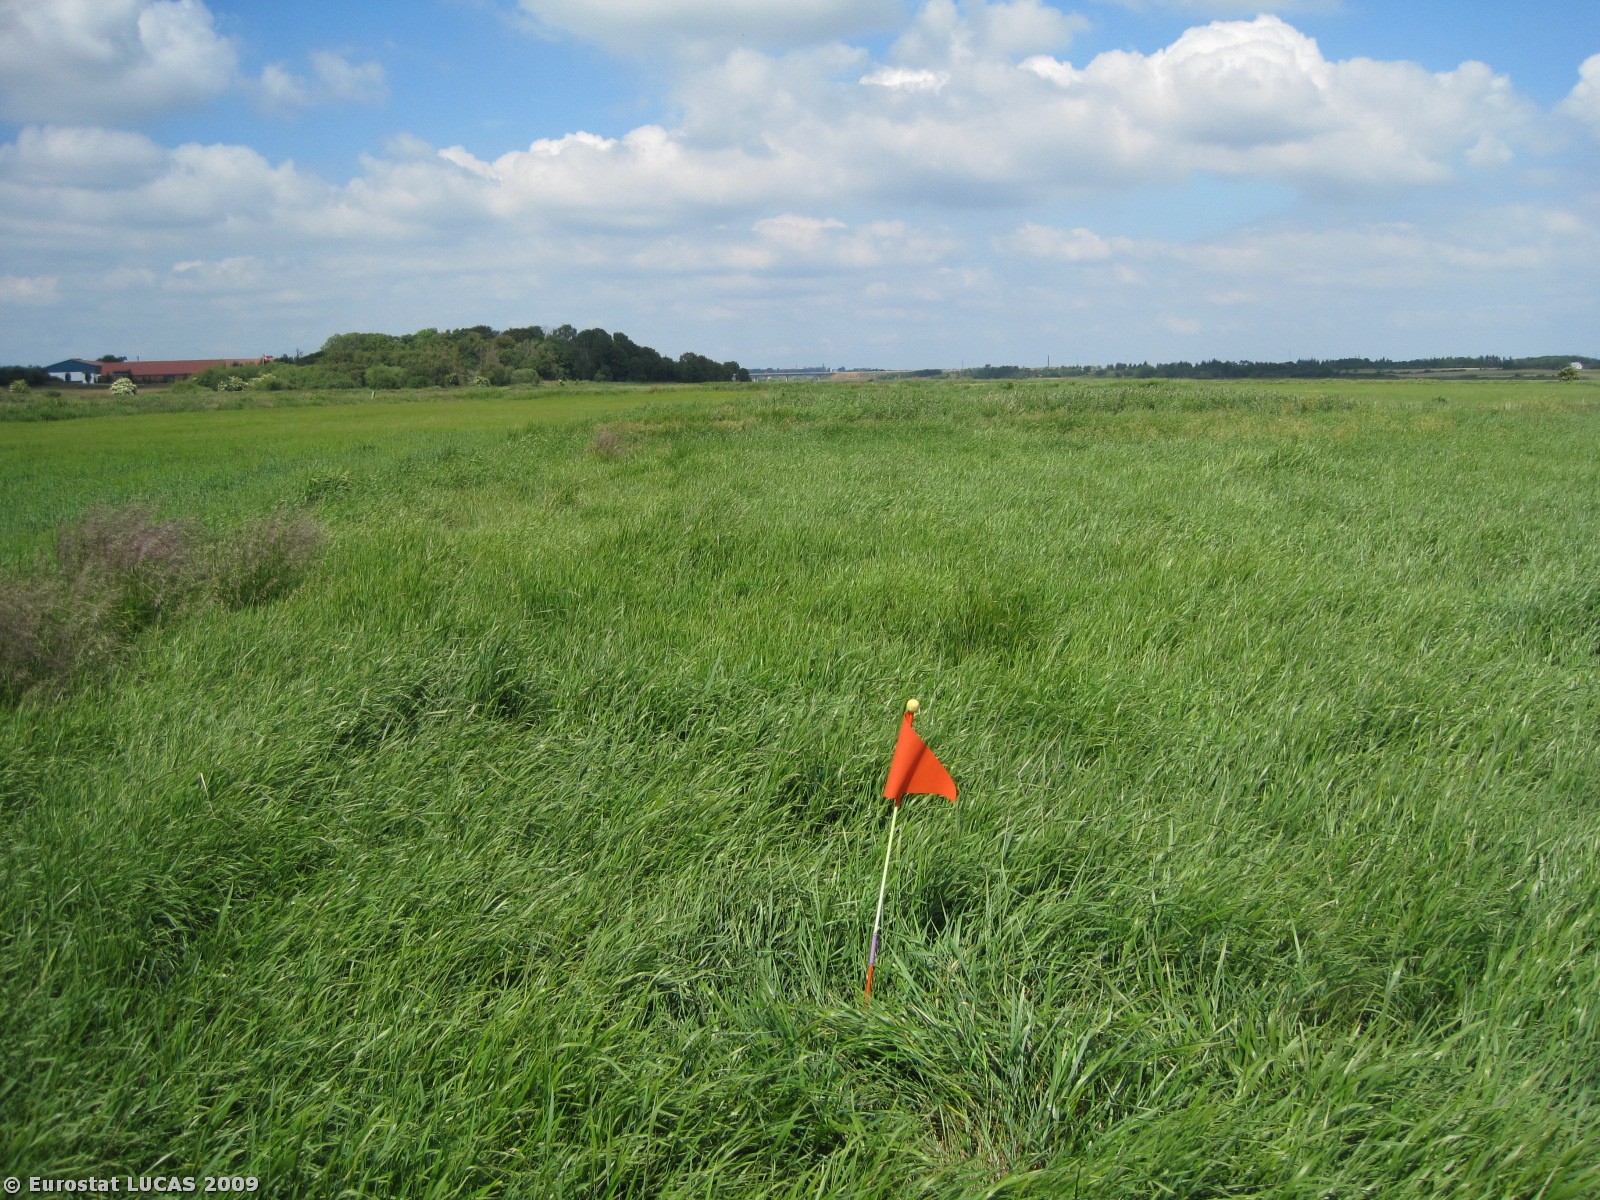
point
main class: Grassland
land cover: Grassland without tree/shrub cover
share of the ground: > 75 %
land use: Agriculture (excluding fallow land and kitchen gardens)
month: June
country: DK
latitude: 56.5252
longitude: 8.9772
